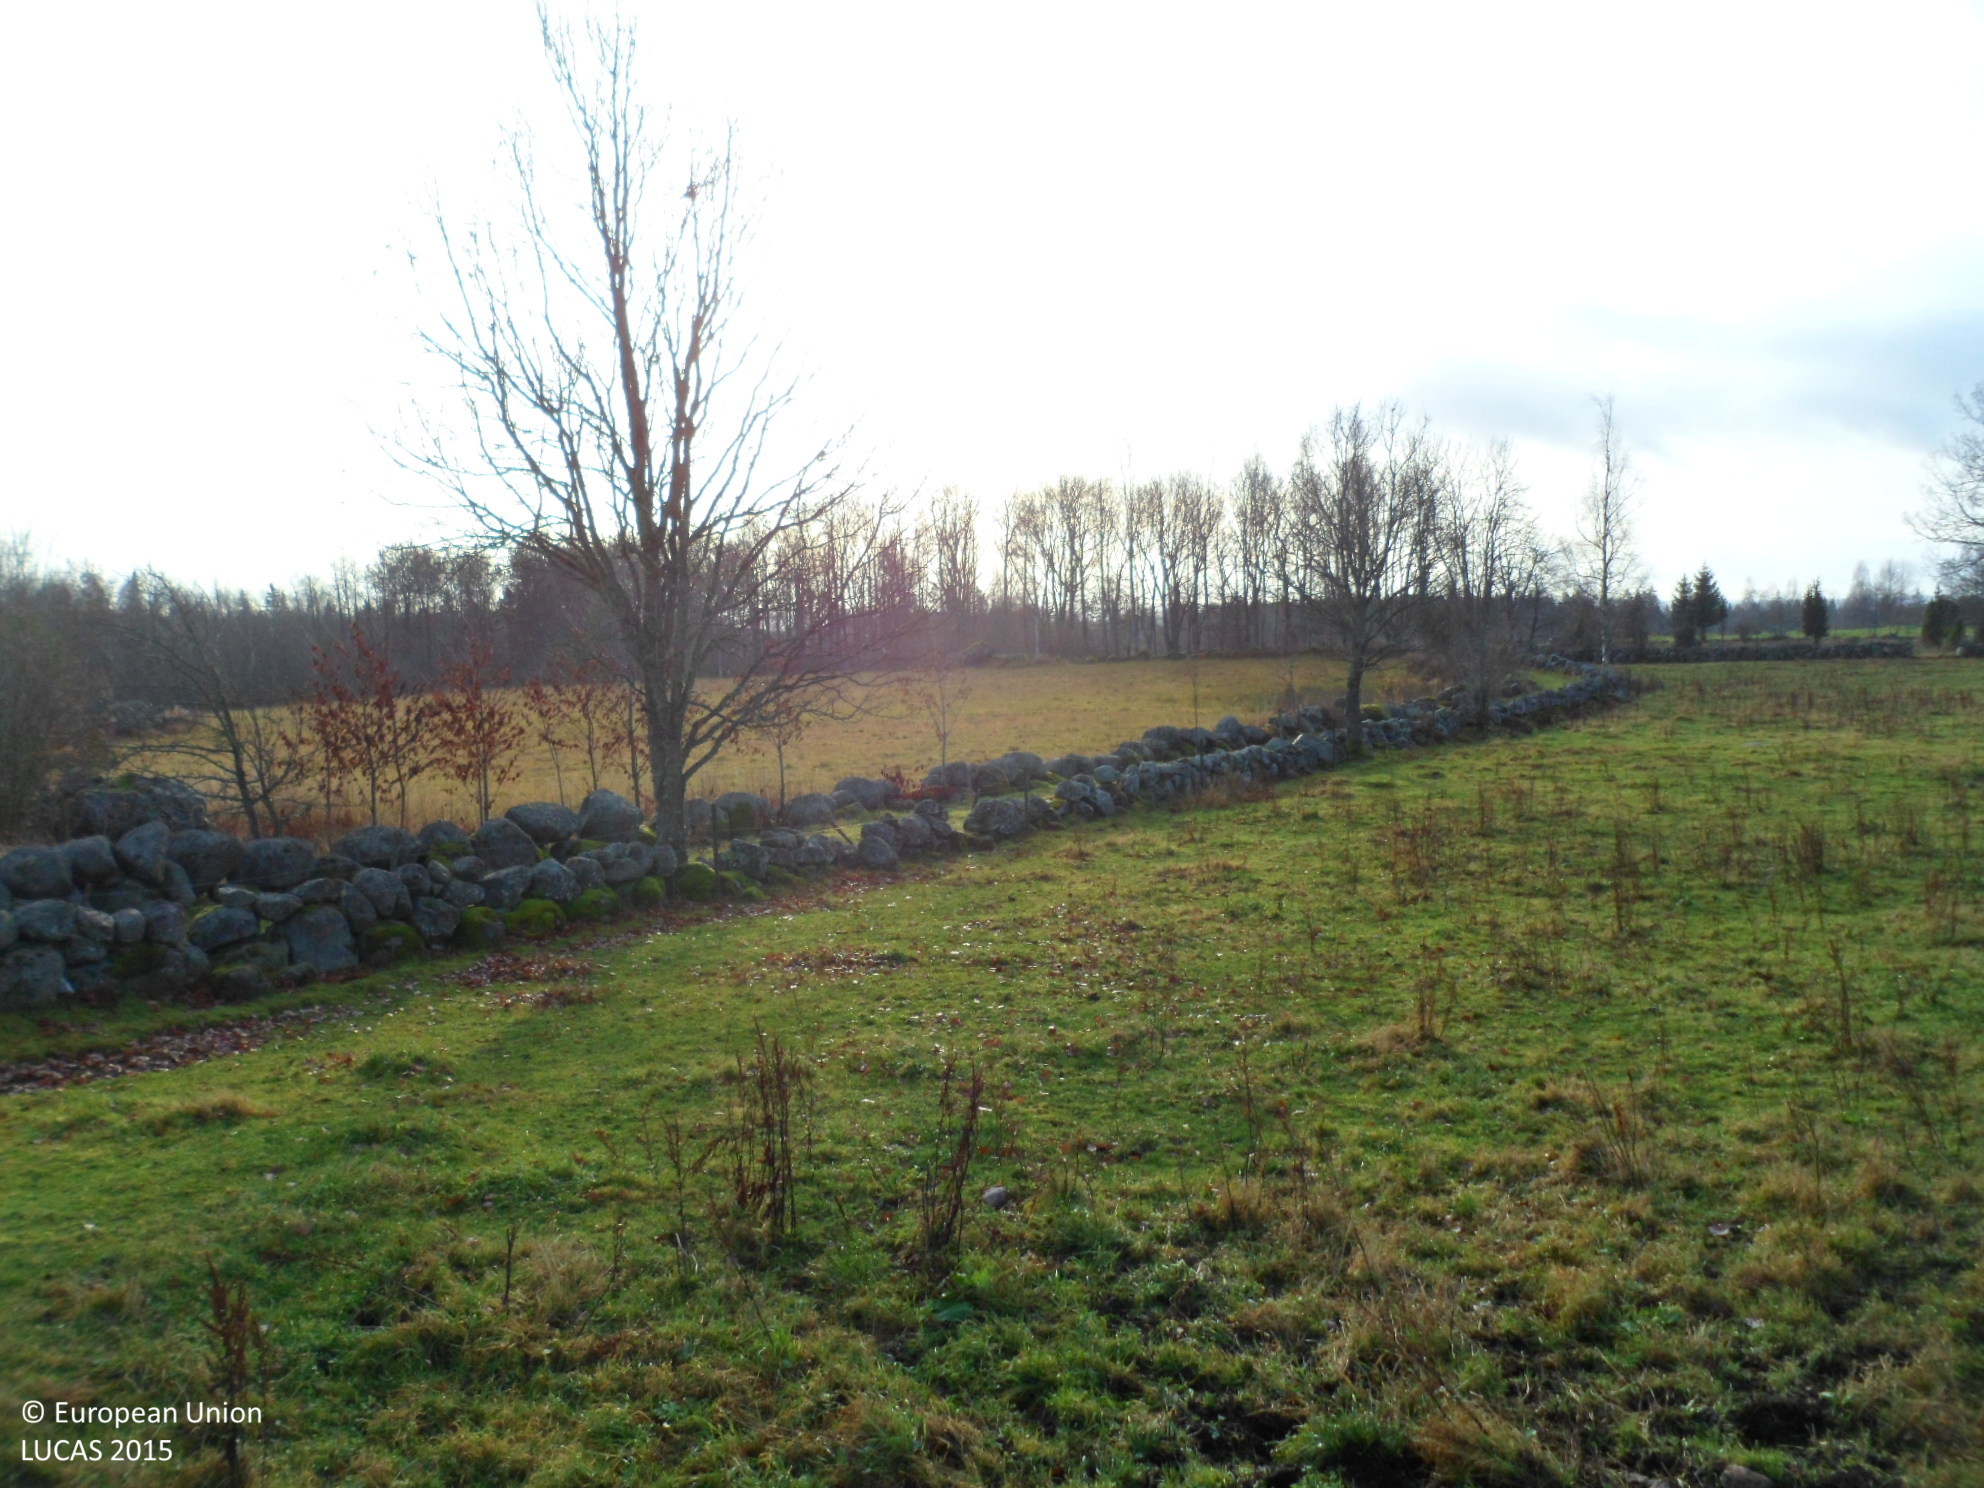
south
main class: Grassland
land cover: Grassland without tree/shrub cover
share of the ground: > 75 %
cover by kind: herbaceous plants 100 %
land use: Agriculture (excluding fallow land and kitchen gardens)
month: November
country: SE
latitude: 57.7275
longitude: 15.5208
